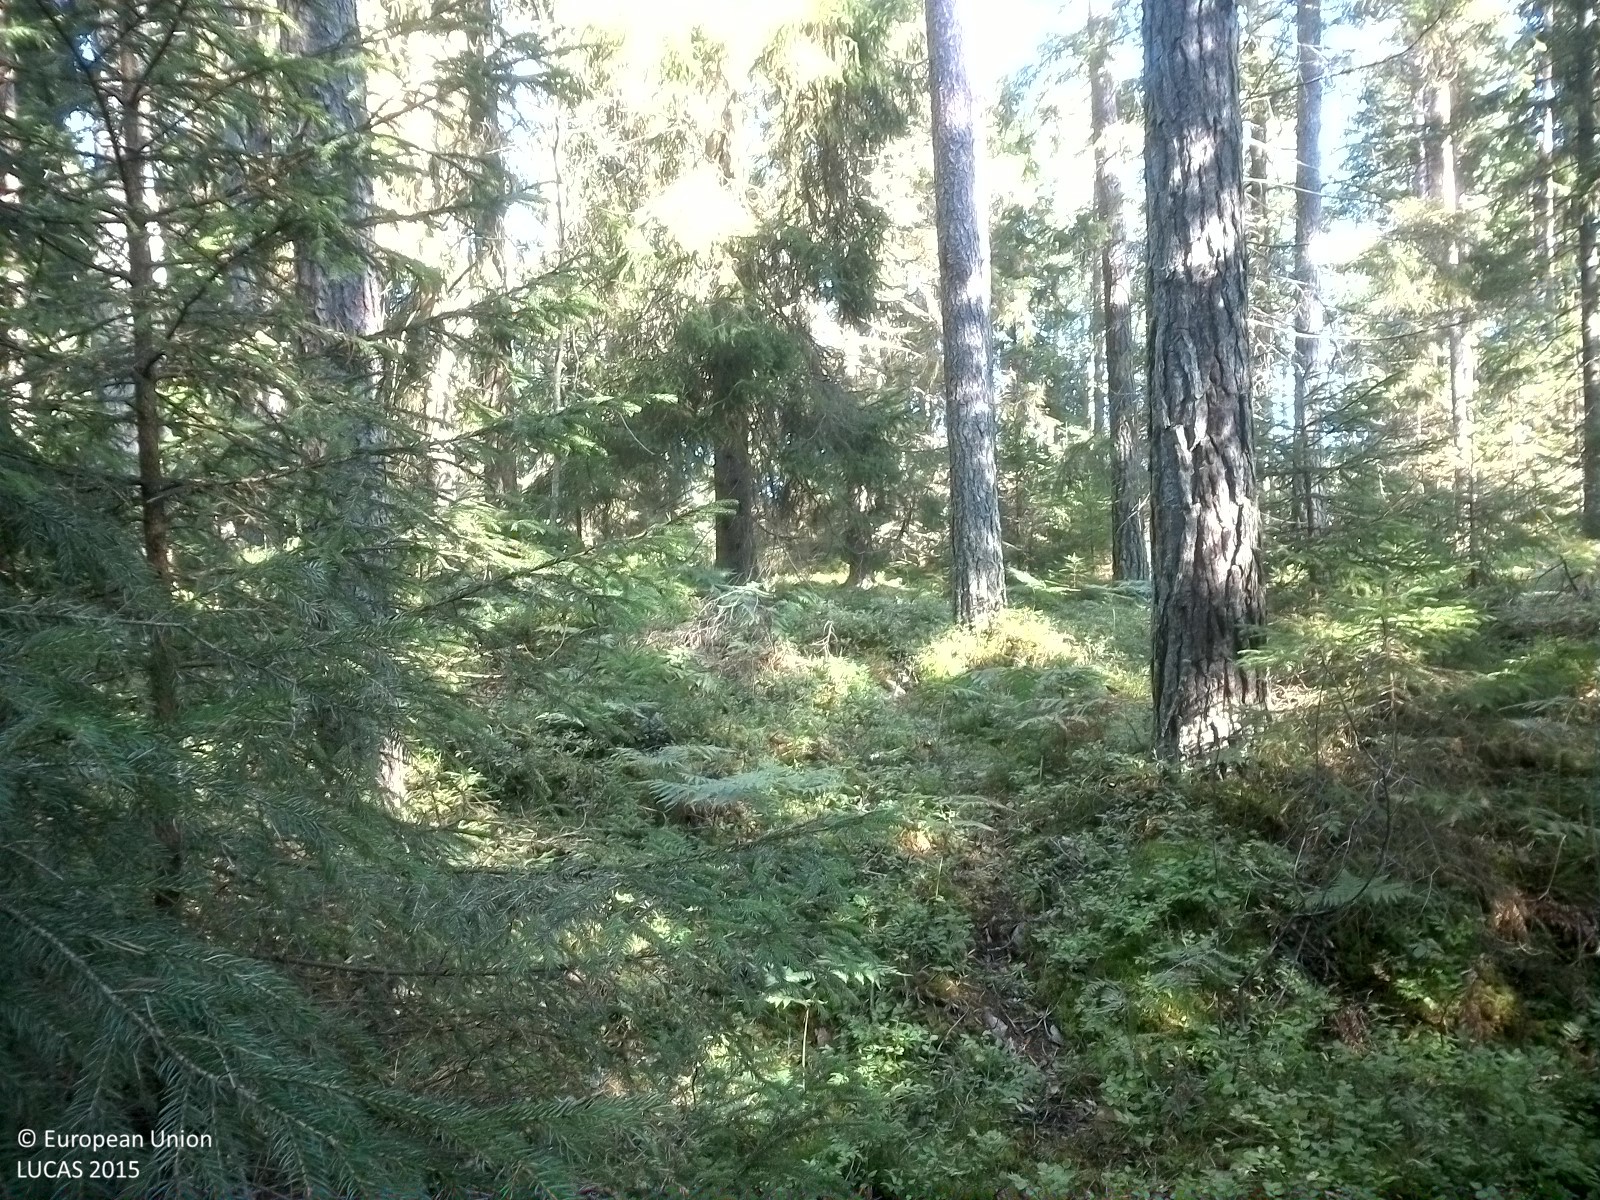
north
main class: Woodland
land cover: Pine dominated coniferous woodland
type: boreal forest
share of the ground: 25 - 50 %
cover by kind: coniferous forest trees 40 %, herbaceous plants 40 %, lichens and mosses 15 %, broadleaved forest trees 5 %
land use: Forestry
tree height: > 5 m
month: September
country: SE
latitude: 59.1194
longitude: 15.8795
